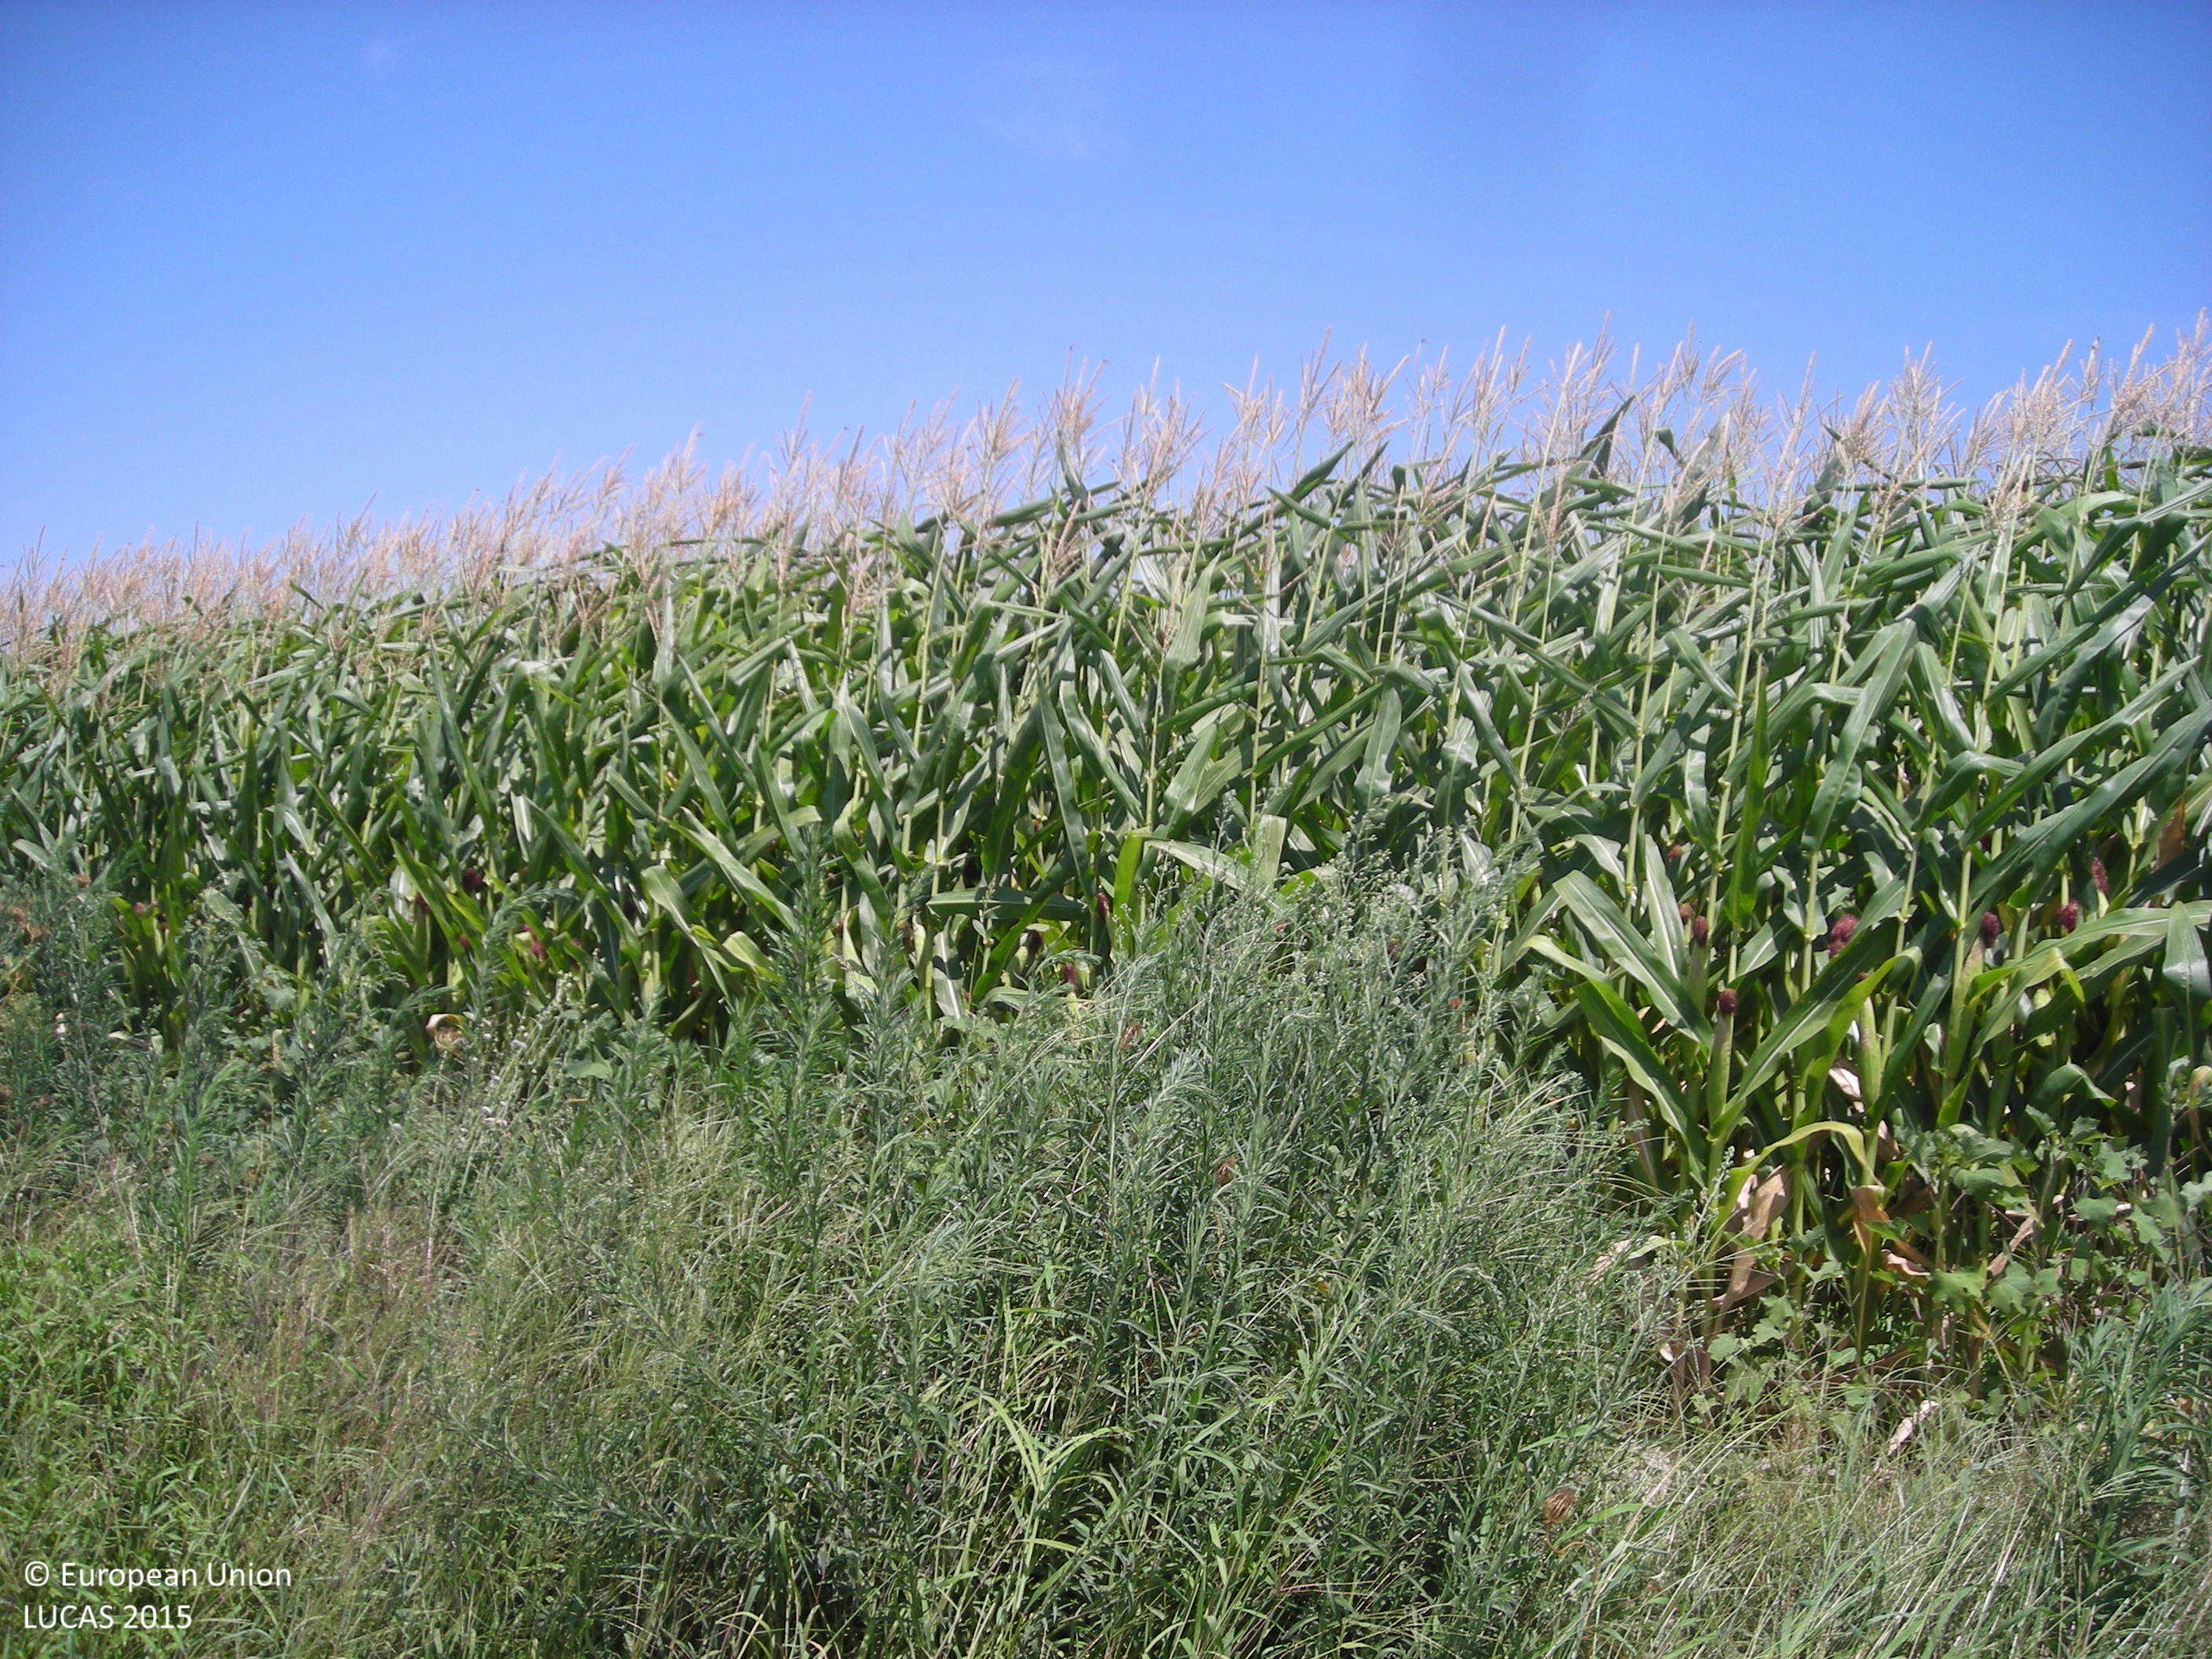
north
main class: Cropland
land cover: Maize
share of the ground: > 75 %
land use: Agriculture (excluding fallow land and kitchen gardens)
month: July
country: ES
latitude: 39.0430
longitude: -5.9621
